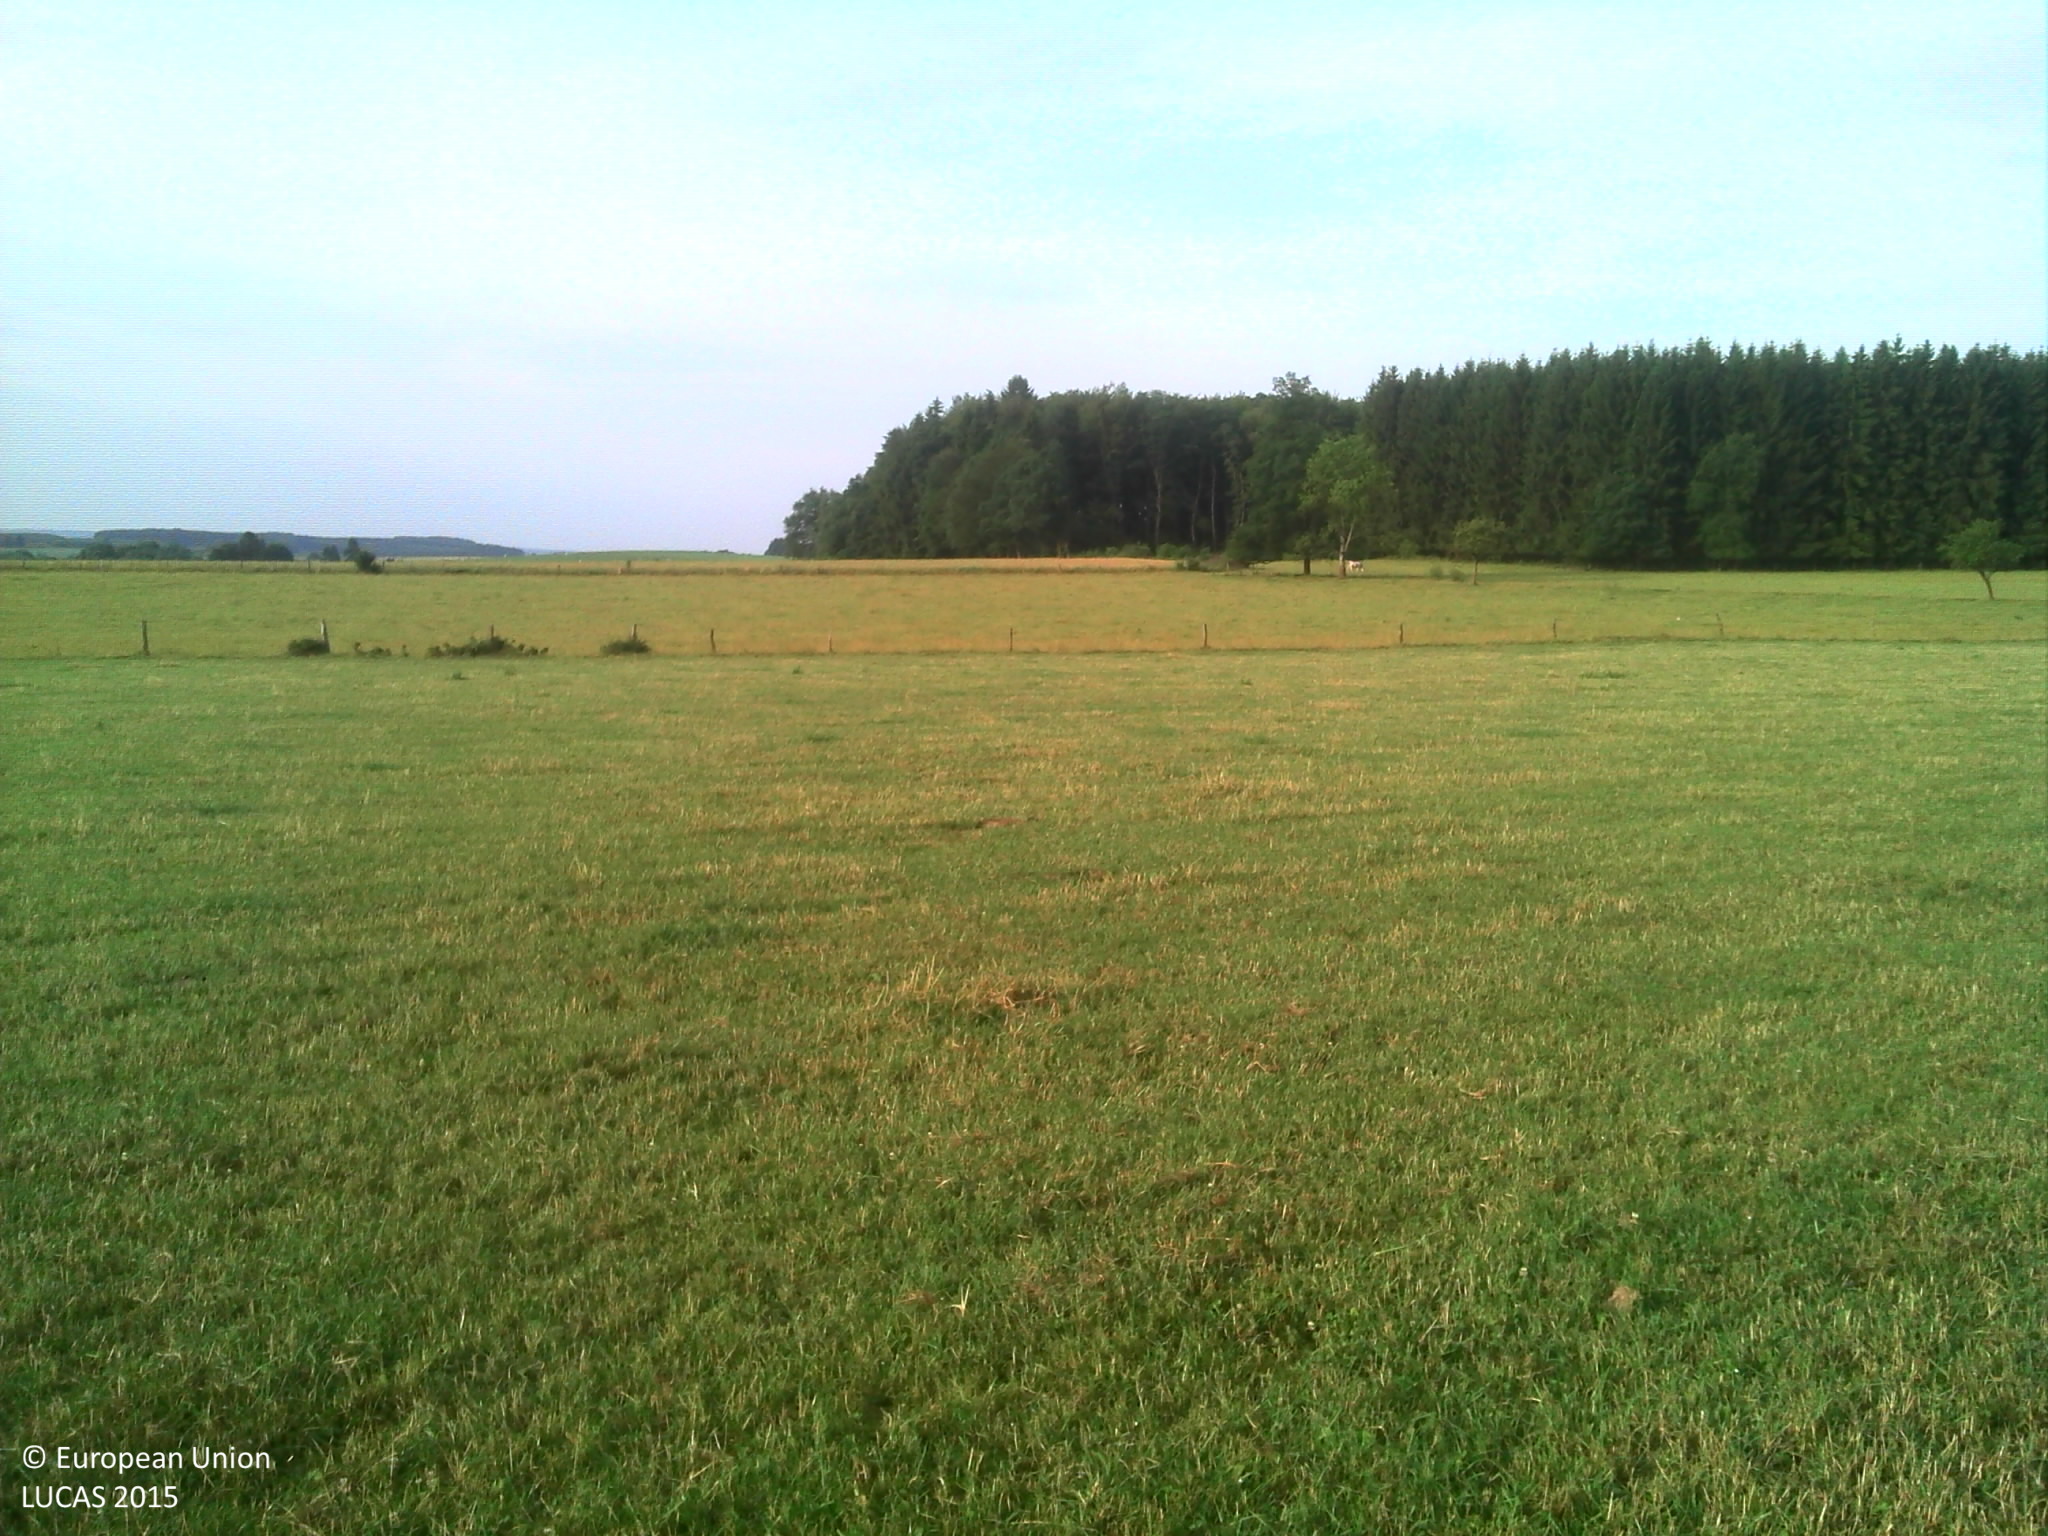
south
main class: Grassland
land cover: Grassland without tree/shrub cover
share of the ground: > 75 %
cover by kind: herbaceous plants 100 %
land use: Agriculture (excluding fallow land and kitchen gardens)
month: July
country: BE
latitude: 49.9398
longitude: 5.6653
